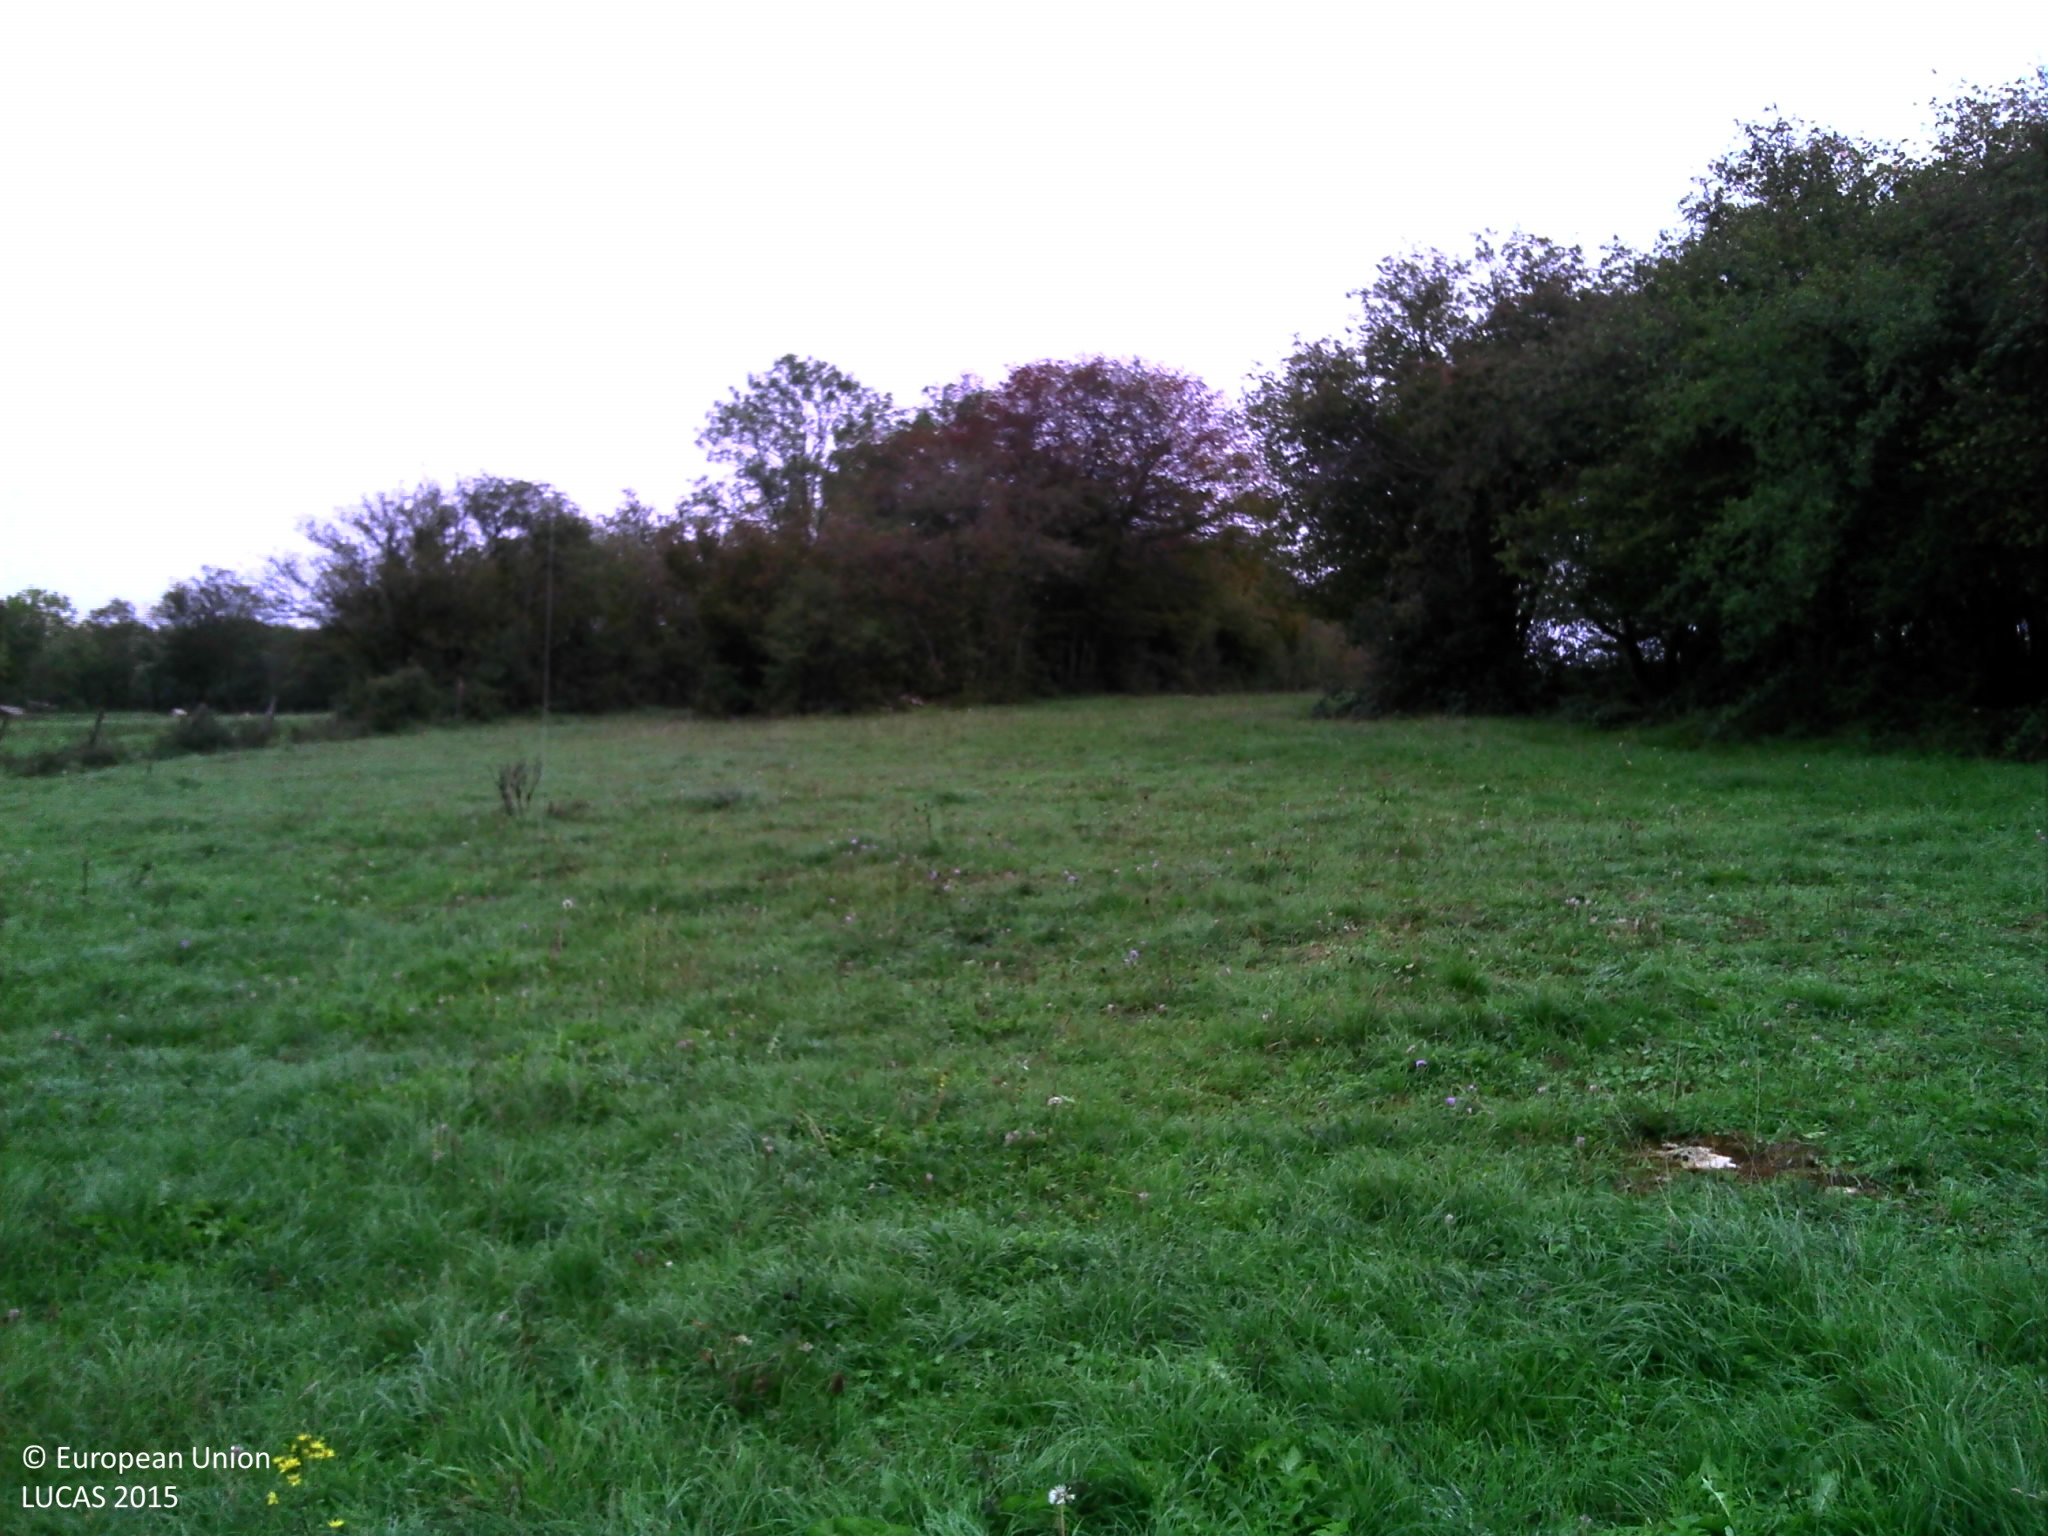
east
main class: Grassland
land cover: Grassland without tree/shrub cover
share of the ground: > 75 %
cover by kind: herbaceous plants 100 %
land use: Agriculture (excluding fallow land and kitchen gardens)
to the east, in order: Grassland without tree/shrub cover; Broadleaved woodland; Grassland without tree/shrub cover; Fences; Broadleaved woodland; Grassland without tree/shrub cover; Broadleaved woodland; Grassland without tree/shrub cover; Broadleaved woodland; Grassland without tree/shrub cover
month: September
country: FR
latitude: 47.1241
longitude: 4.7409
